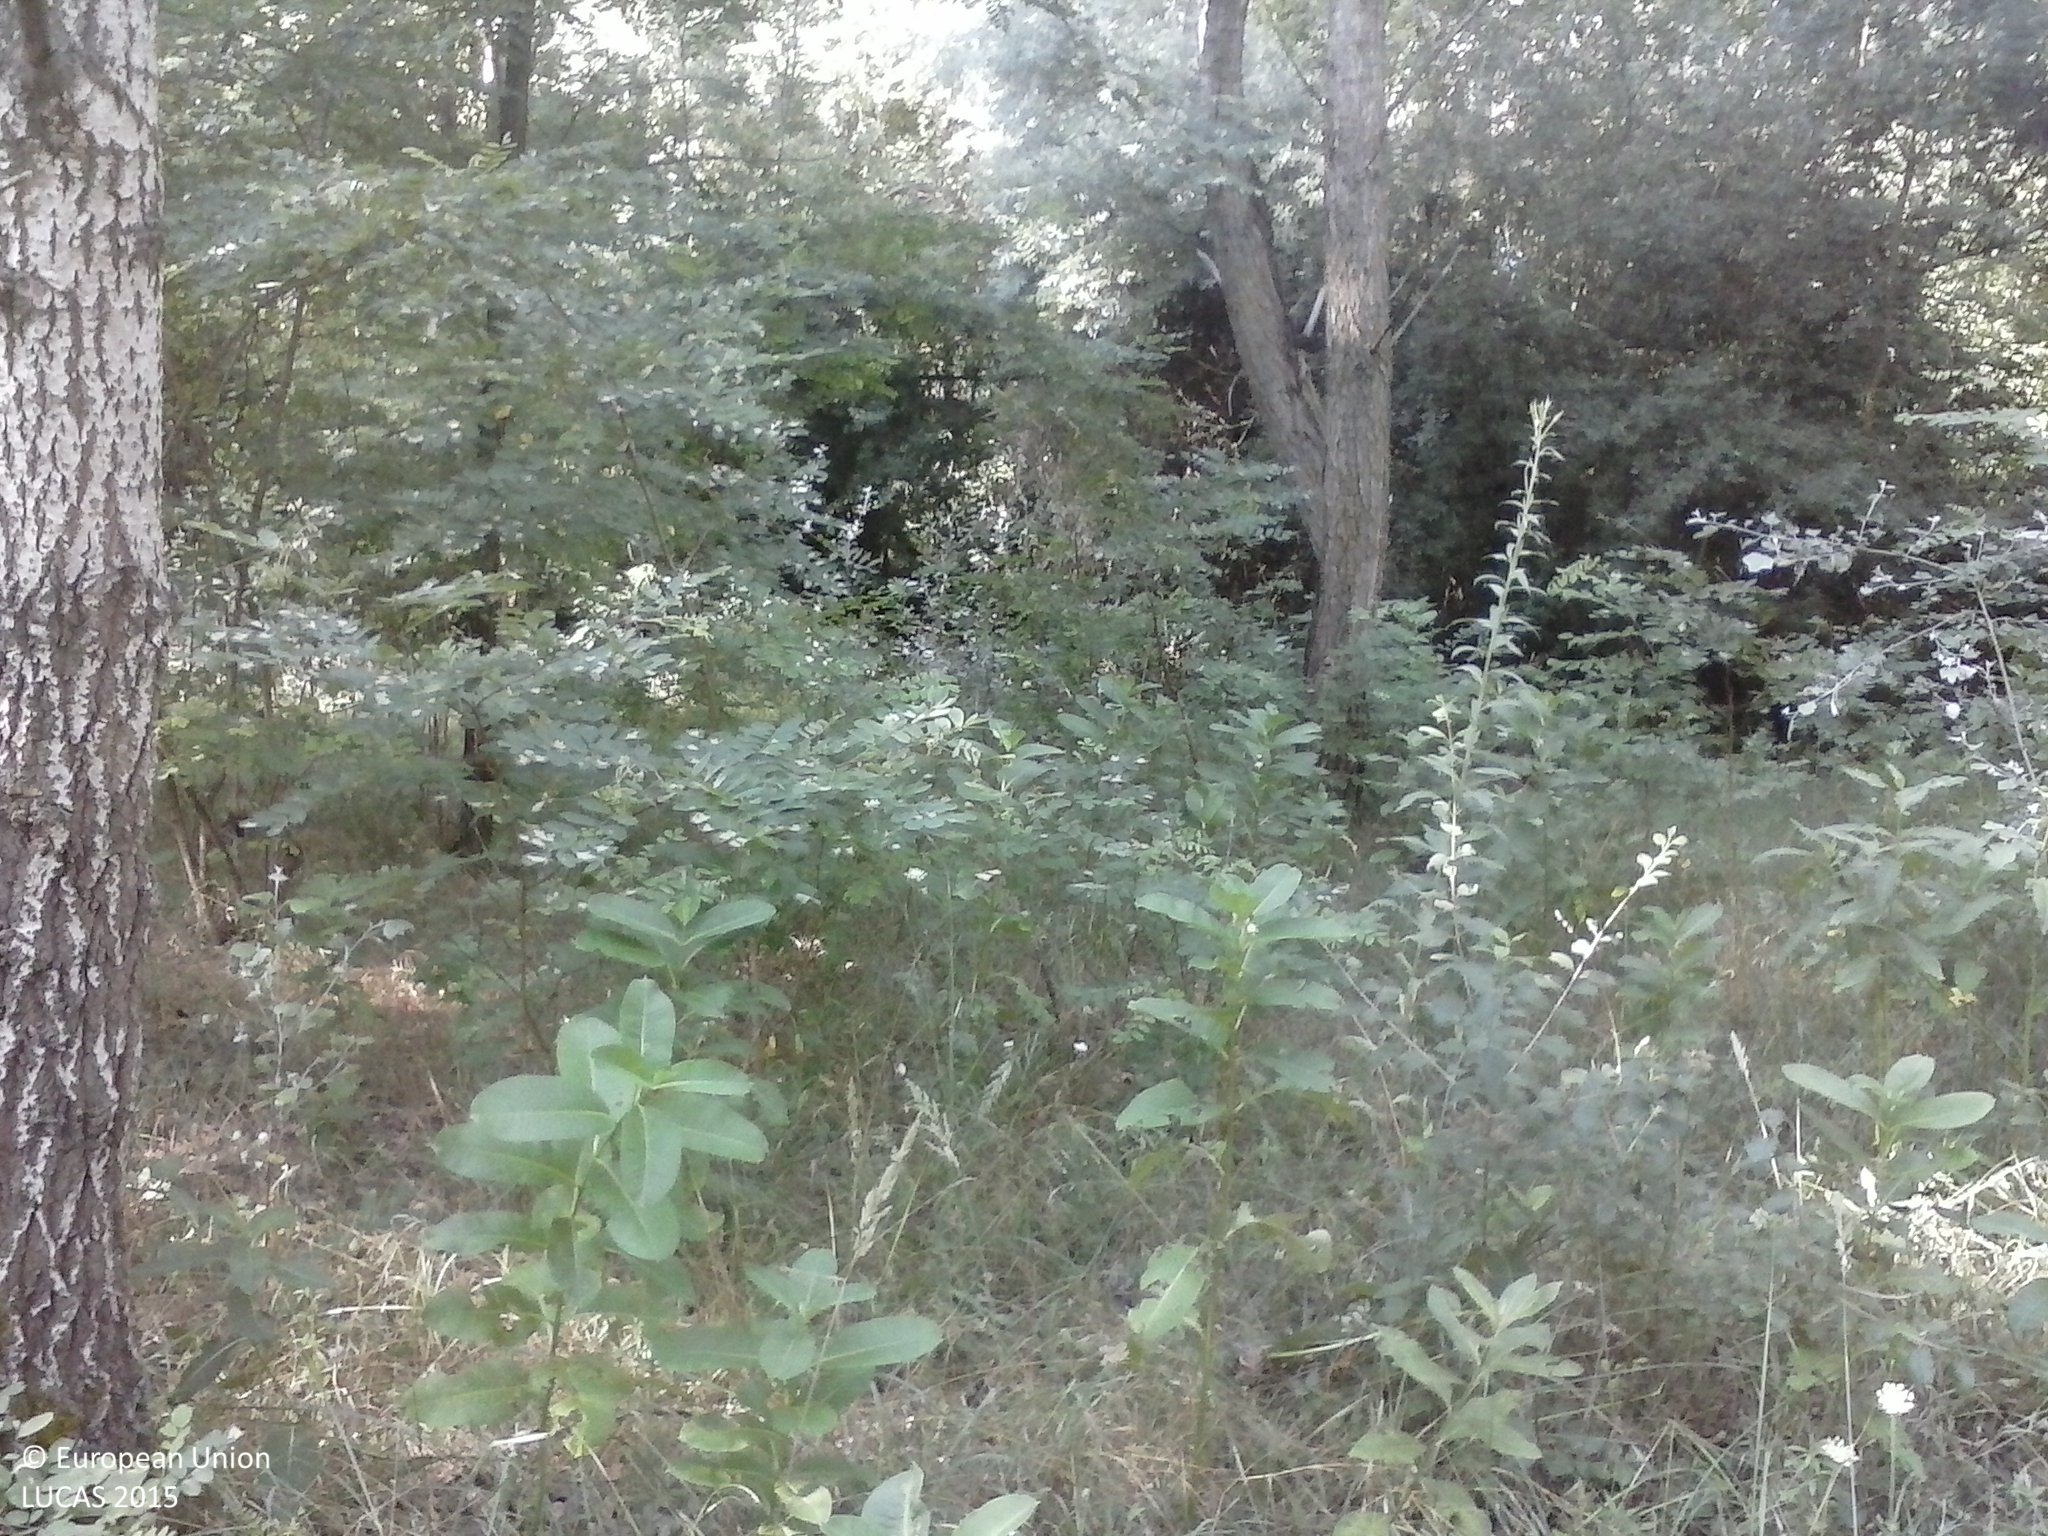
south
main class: Woodland
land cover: Broadleaved woodland
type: non-riverine alder, birch or aspen forest
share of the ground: > 75 %
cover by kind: broadleaved forest trees 80 %, shrubs 10 %, herbaceous plants 10 %
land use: Forestry
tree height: > 5 m
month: July
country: HU
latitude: 46.5325
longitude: 19.6276
